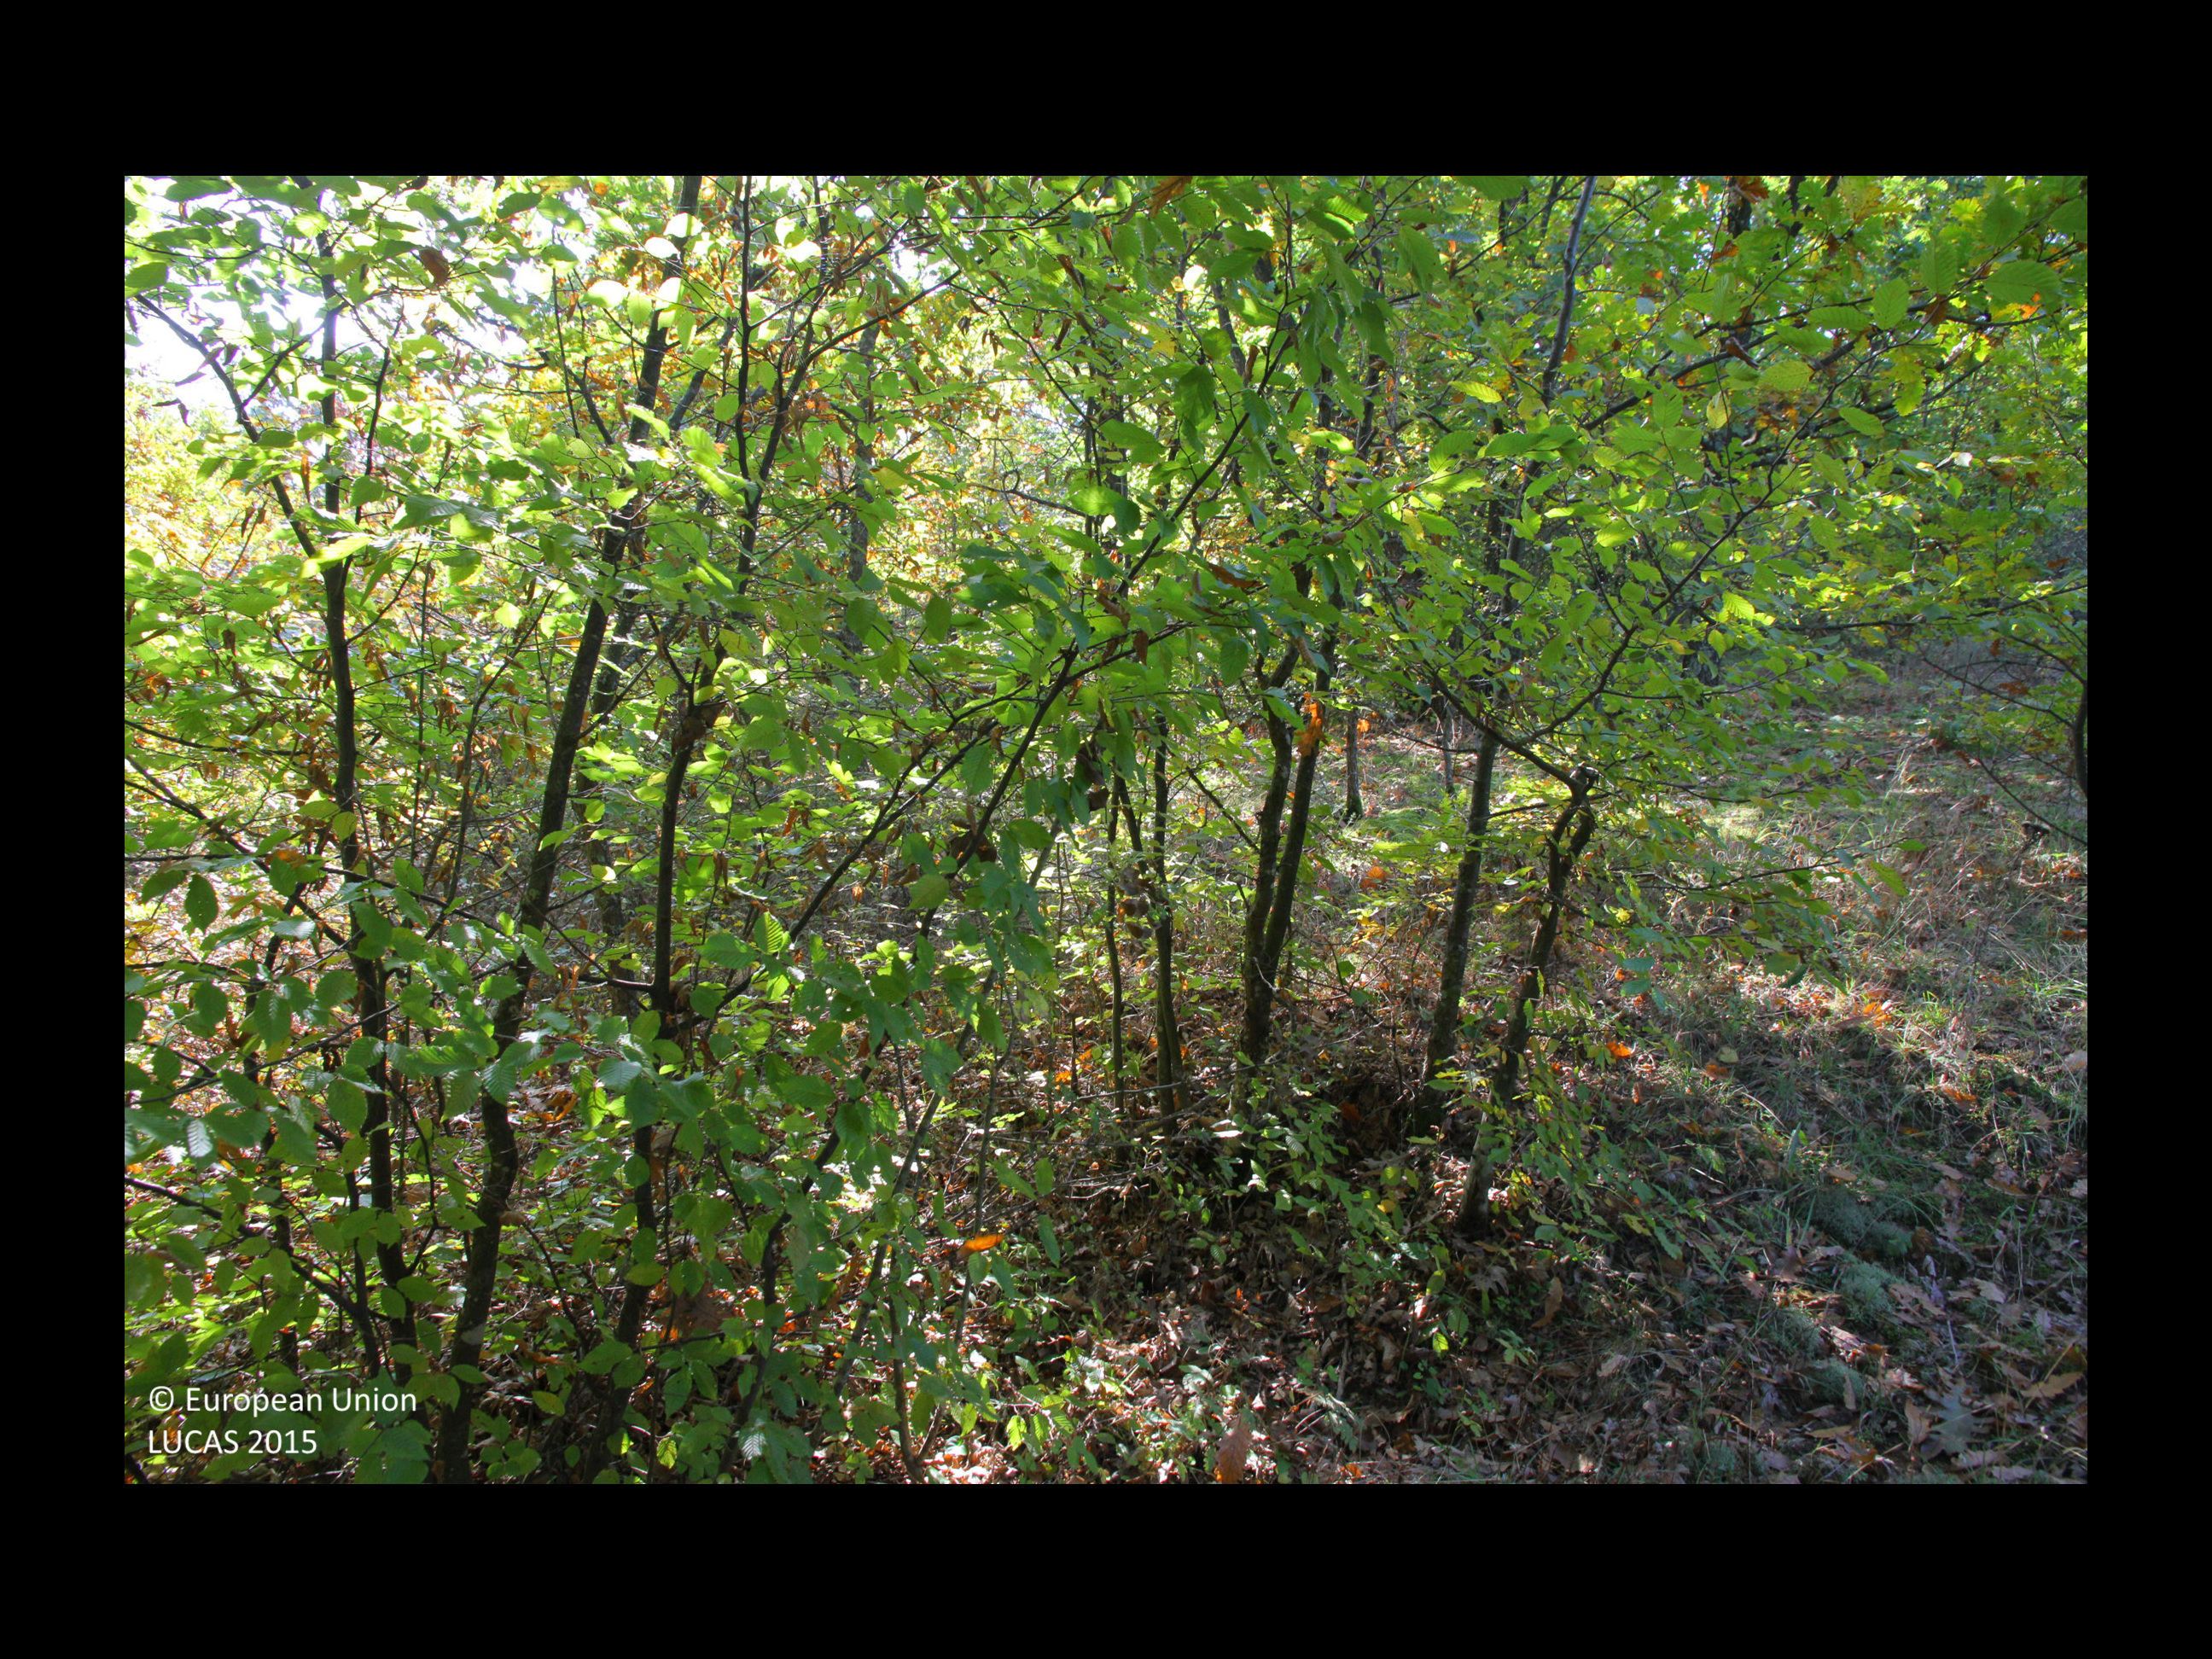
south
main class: Woodland
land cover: Broadleaved woodland
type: mesophytic deciduous forest
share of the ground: > 75 %
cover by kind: broadleaved forest trees 100 %
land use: Forestry
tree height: > 5 m
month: October
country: BG
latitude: 42.9986
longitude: 26.9517
